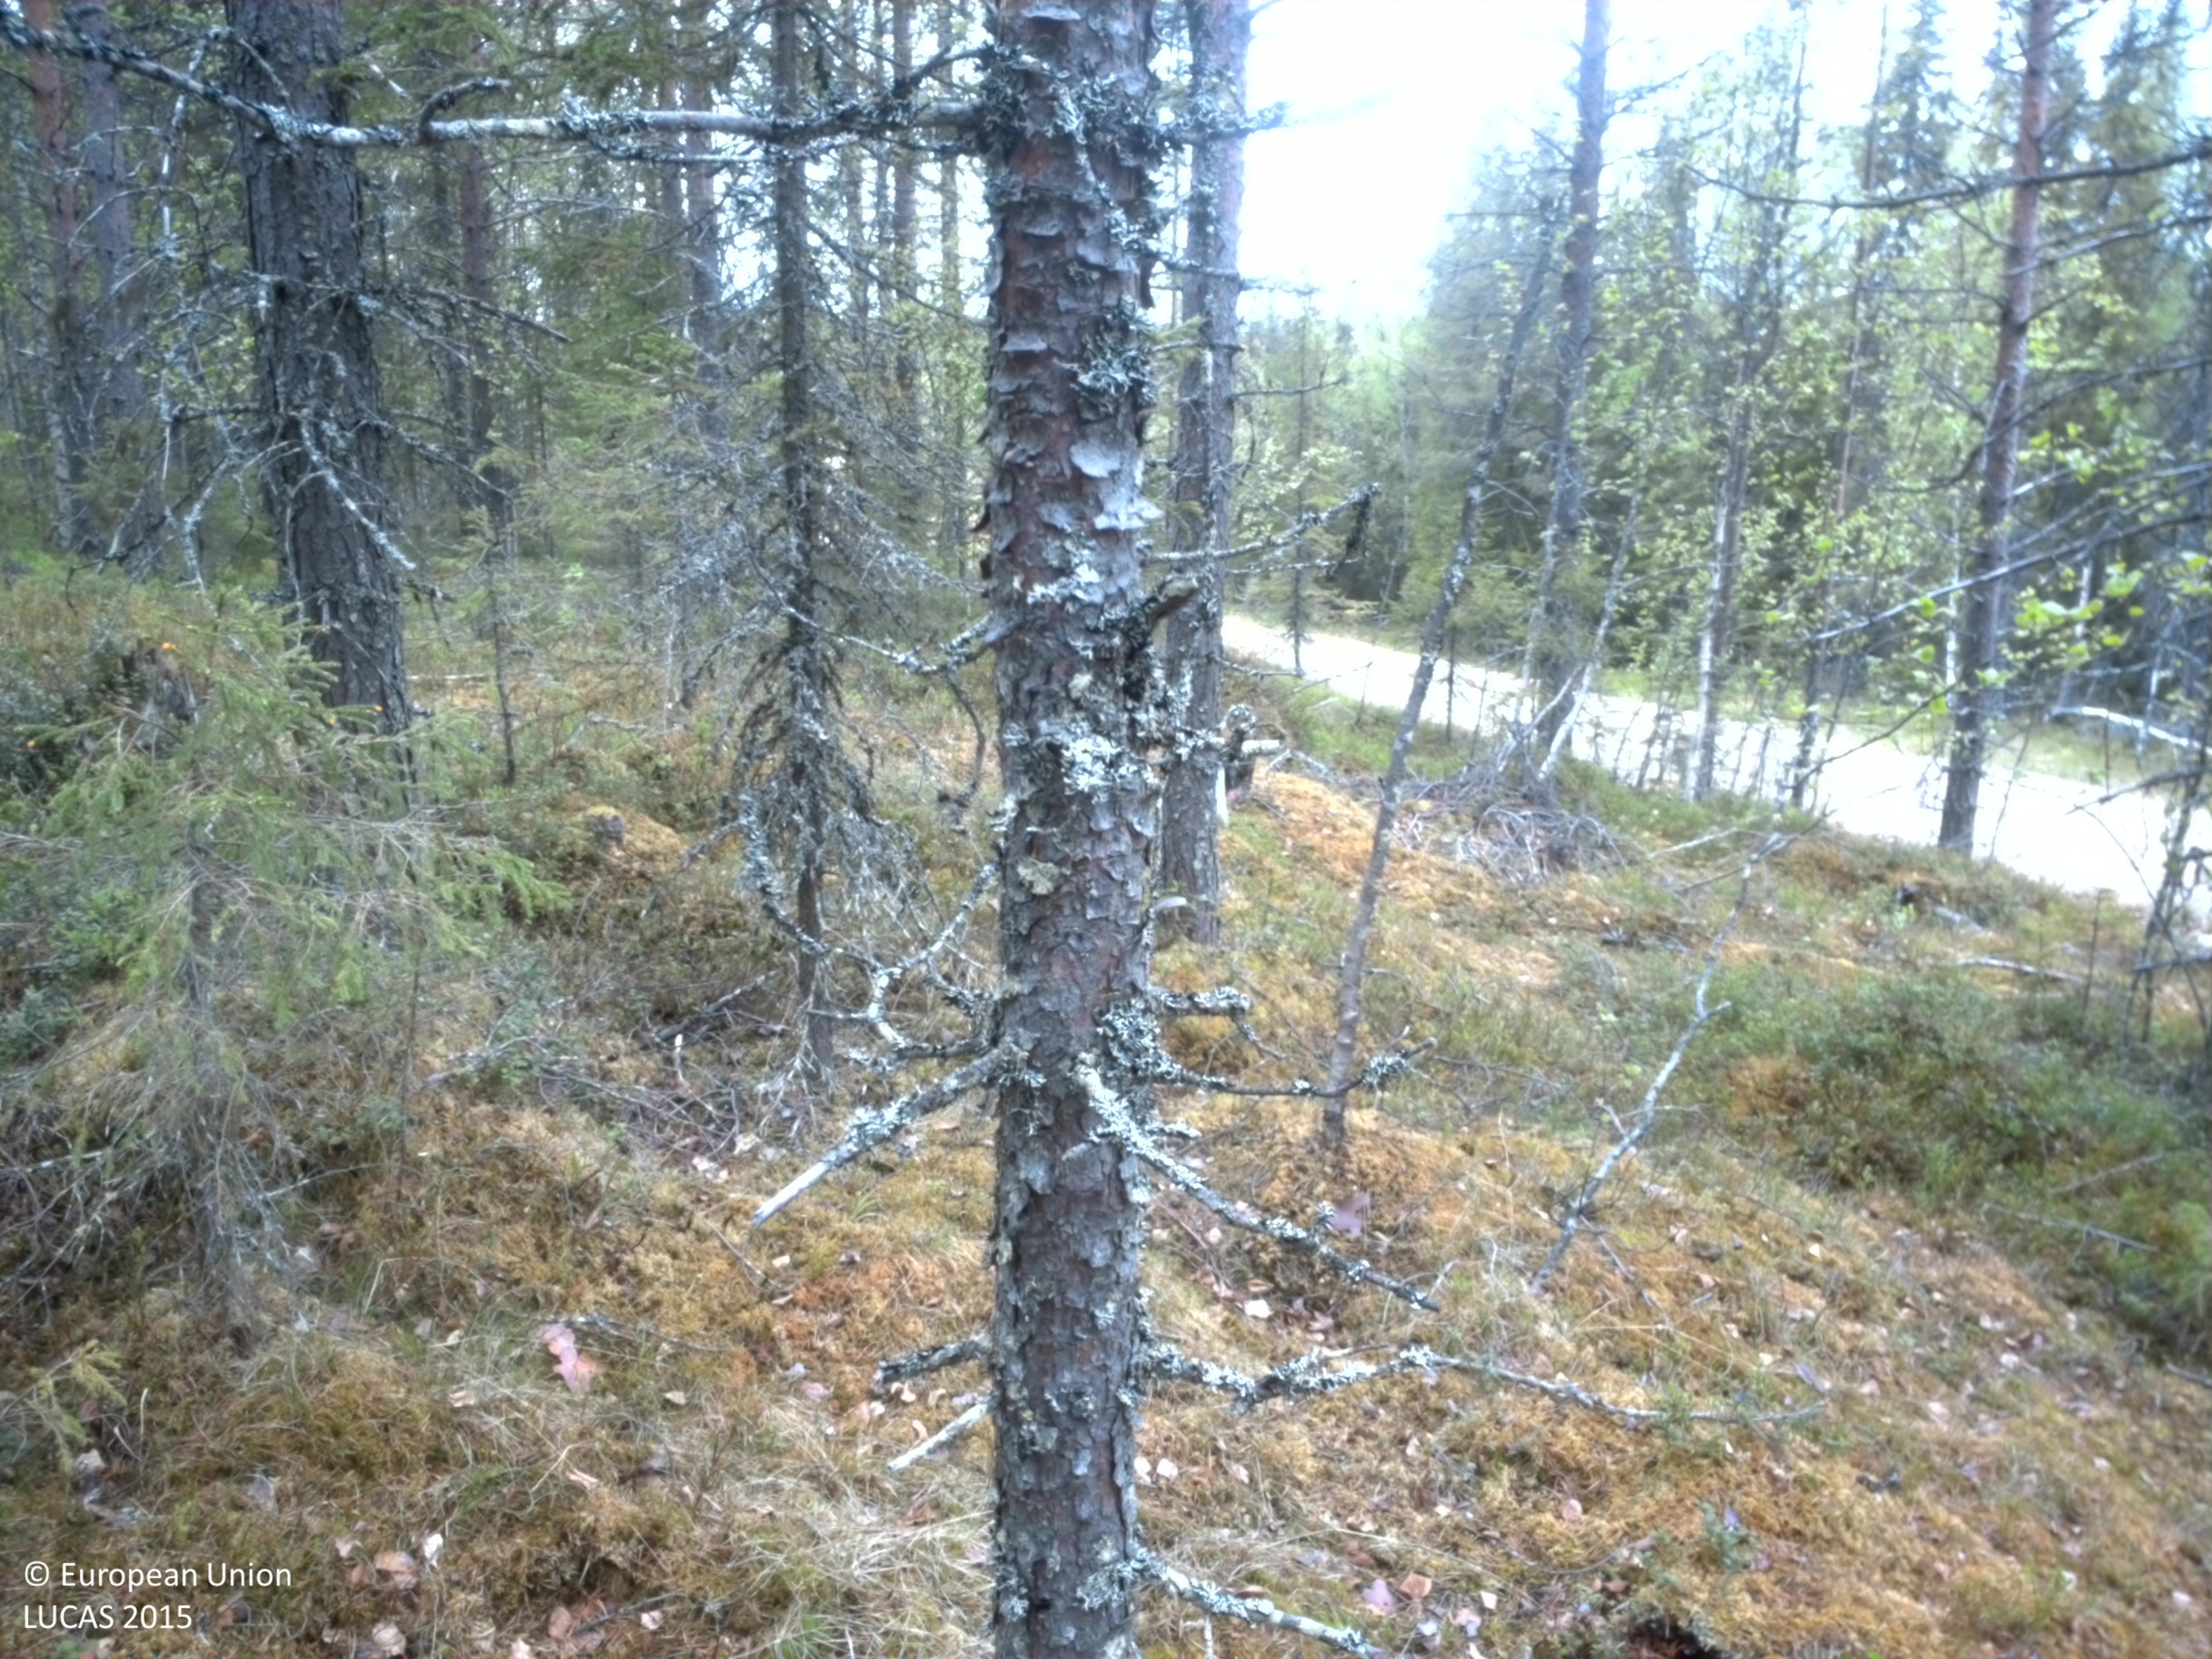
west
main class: Woodland
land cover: Pine dominated mixed woodland
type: boreal forest
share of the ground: 25 - 50 %
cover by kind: herbaceous plants 40 %, coniferous forest trees 25 %, lichens and mosses 15 %, broadleaved forest trees 10 %, shrubs 10 %
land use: Forestry
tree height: > 5 m
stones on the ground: < 10 %
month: June
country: SE
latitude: 66.6990
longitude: 22.4056
